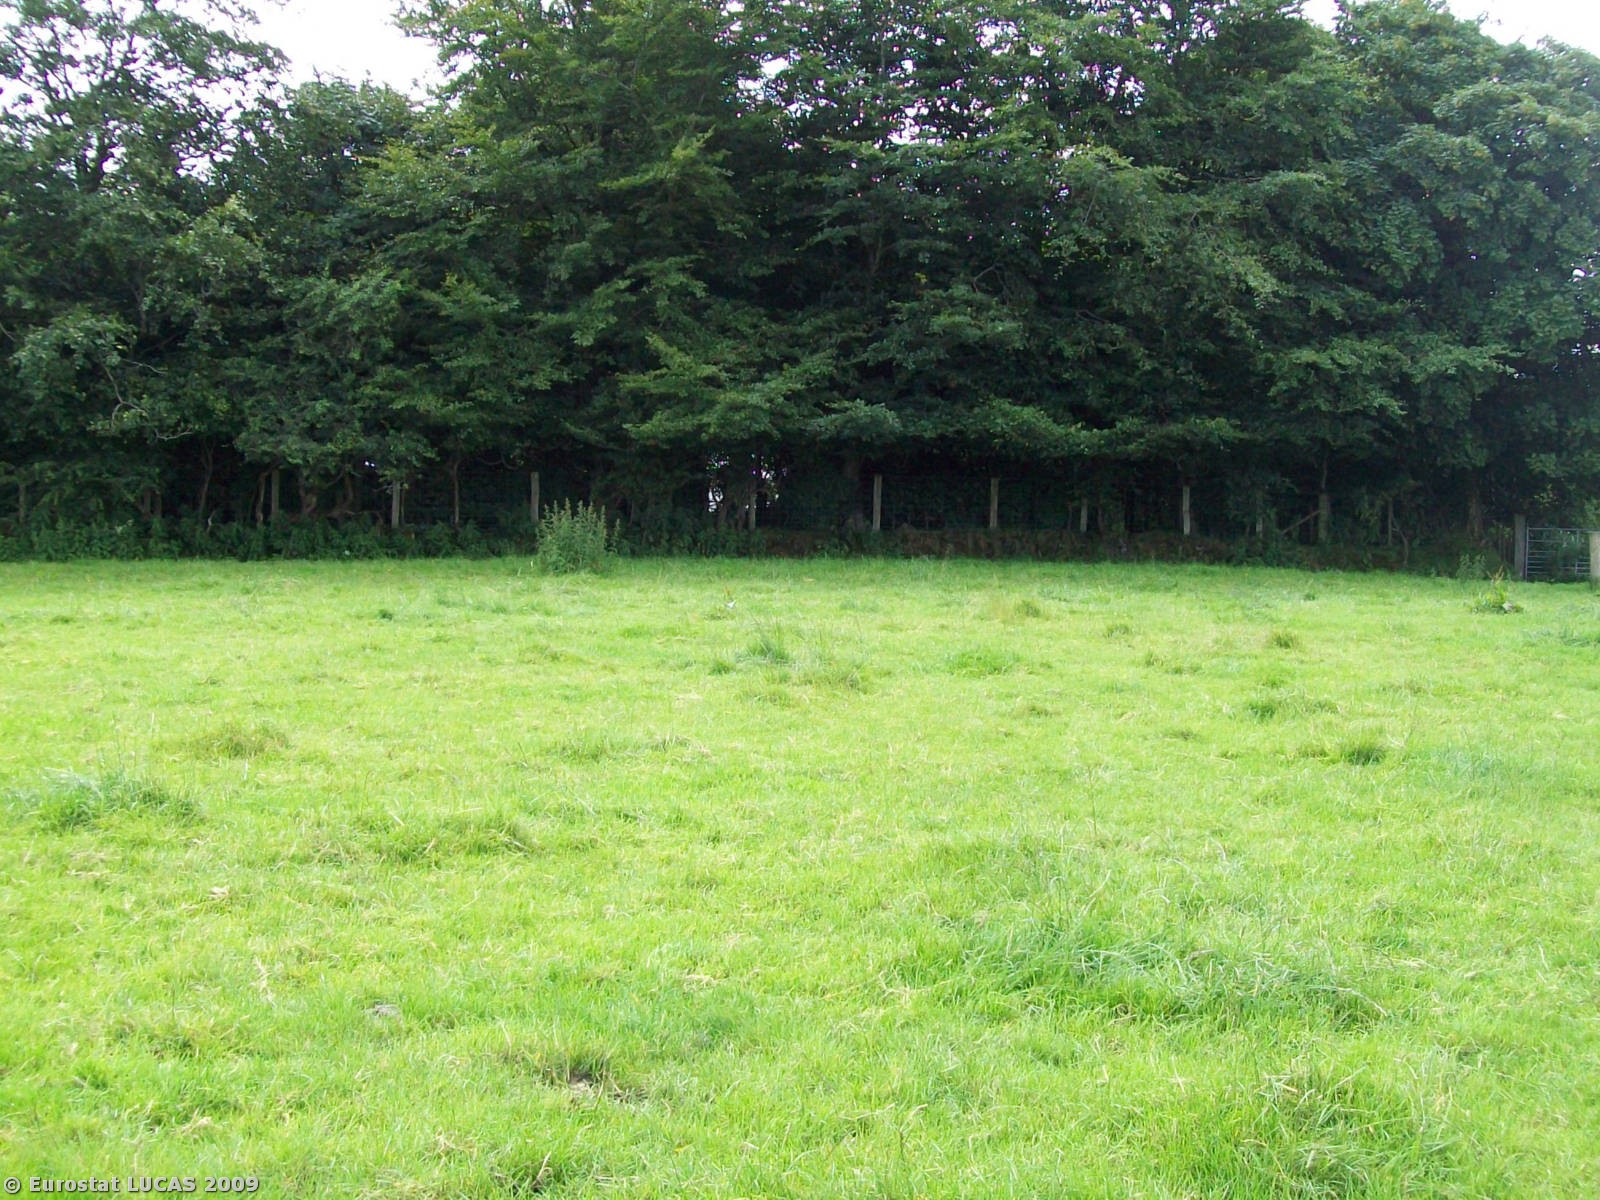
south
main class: Grassland
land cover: Grassland without tree/shrub cover
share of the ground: > 75 %
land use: Agriculture (excluding fallow land and kitchen gardens)
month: July
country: GB
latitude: 55.1148
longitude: -6.3119
